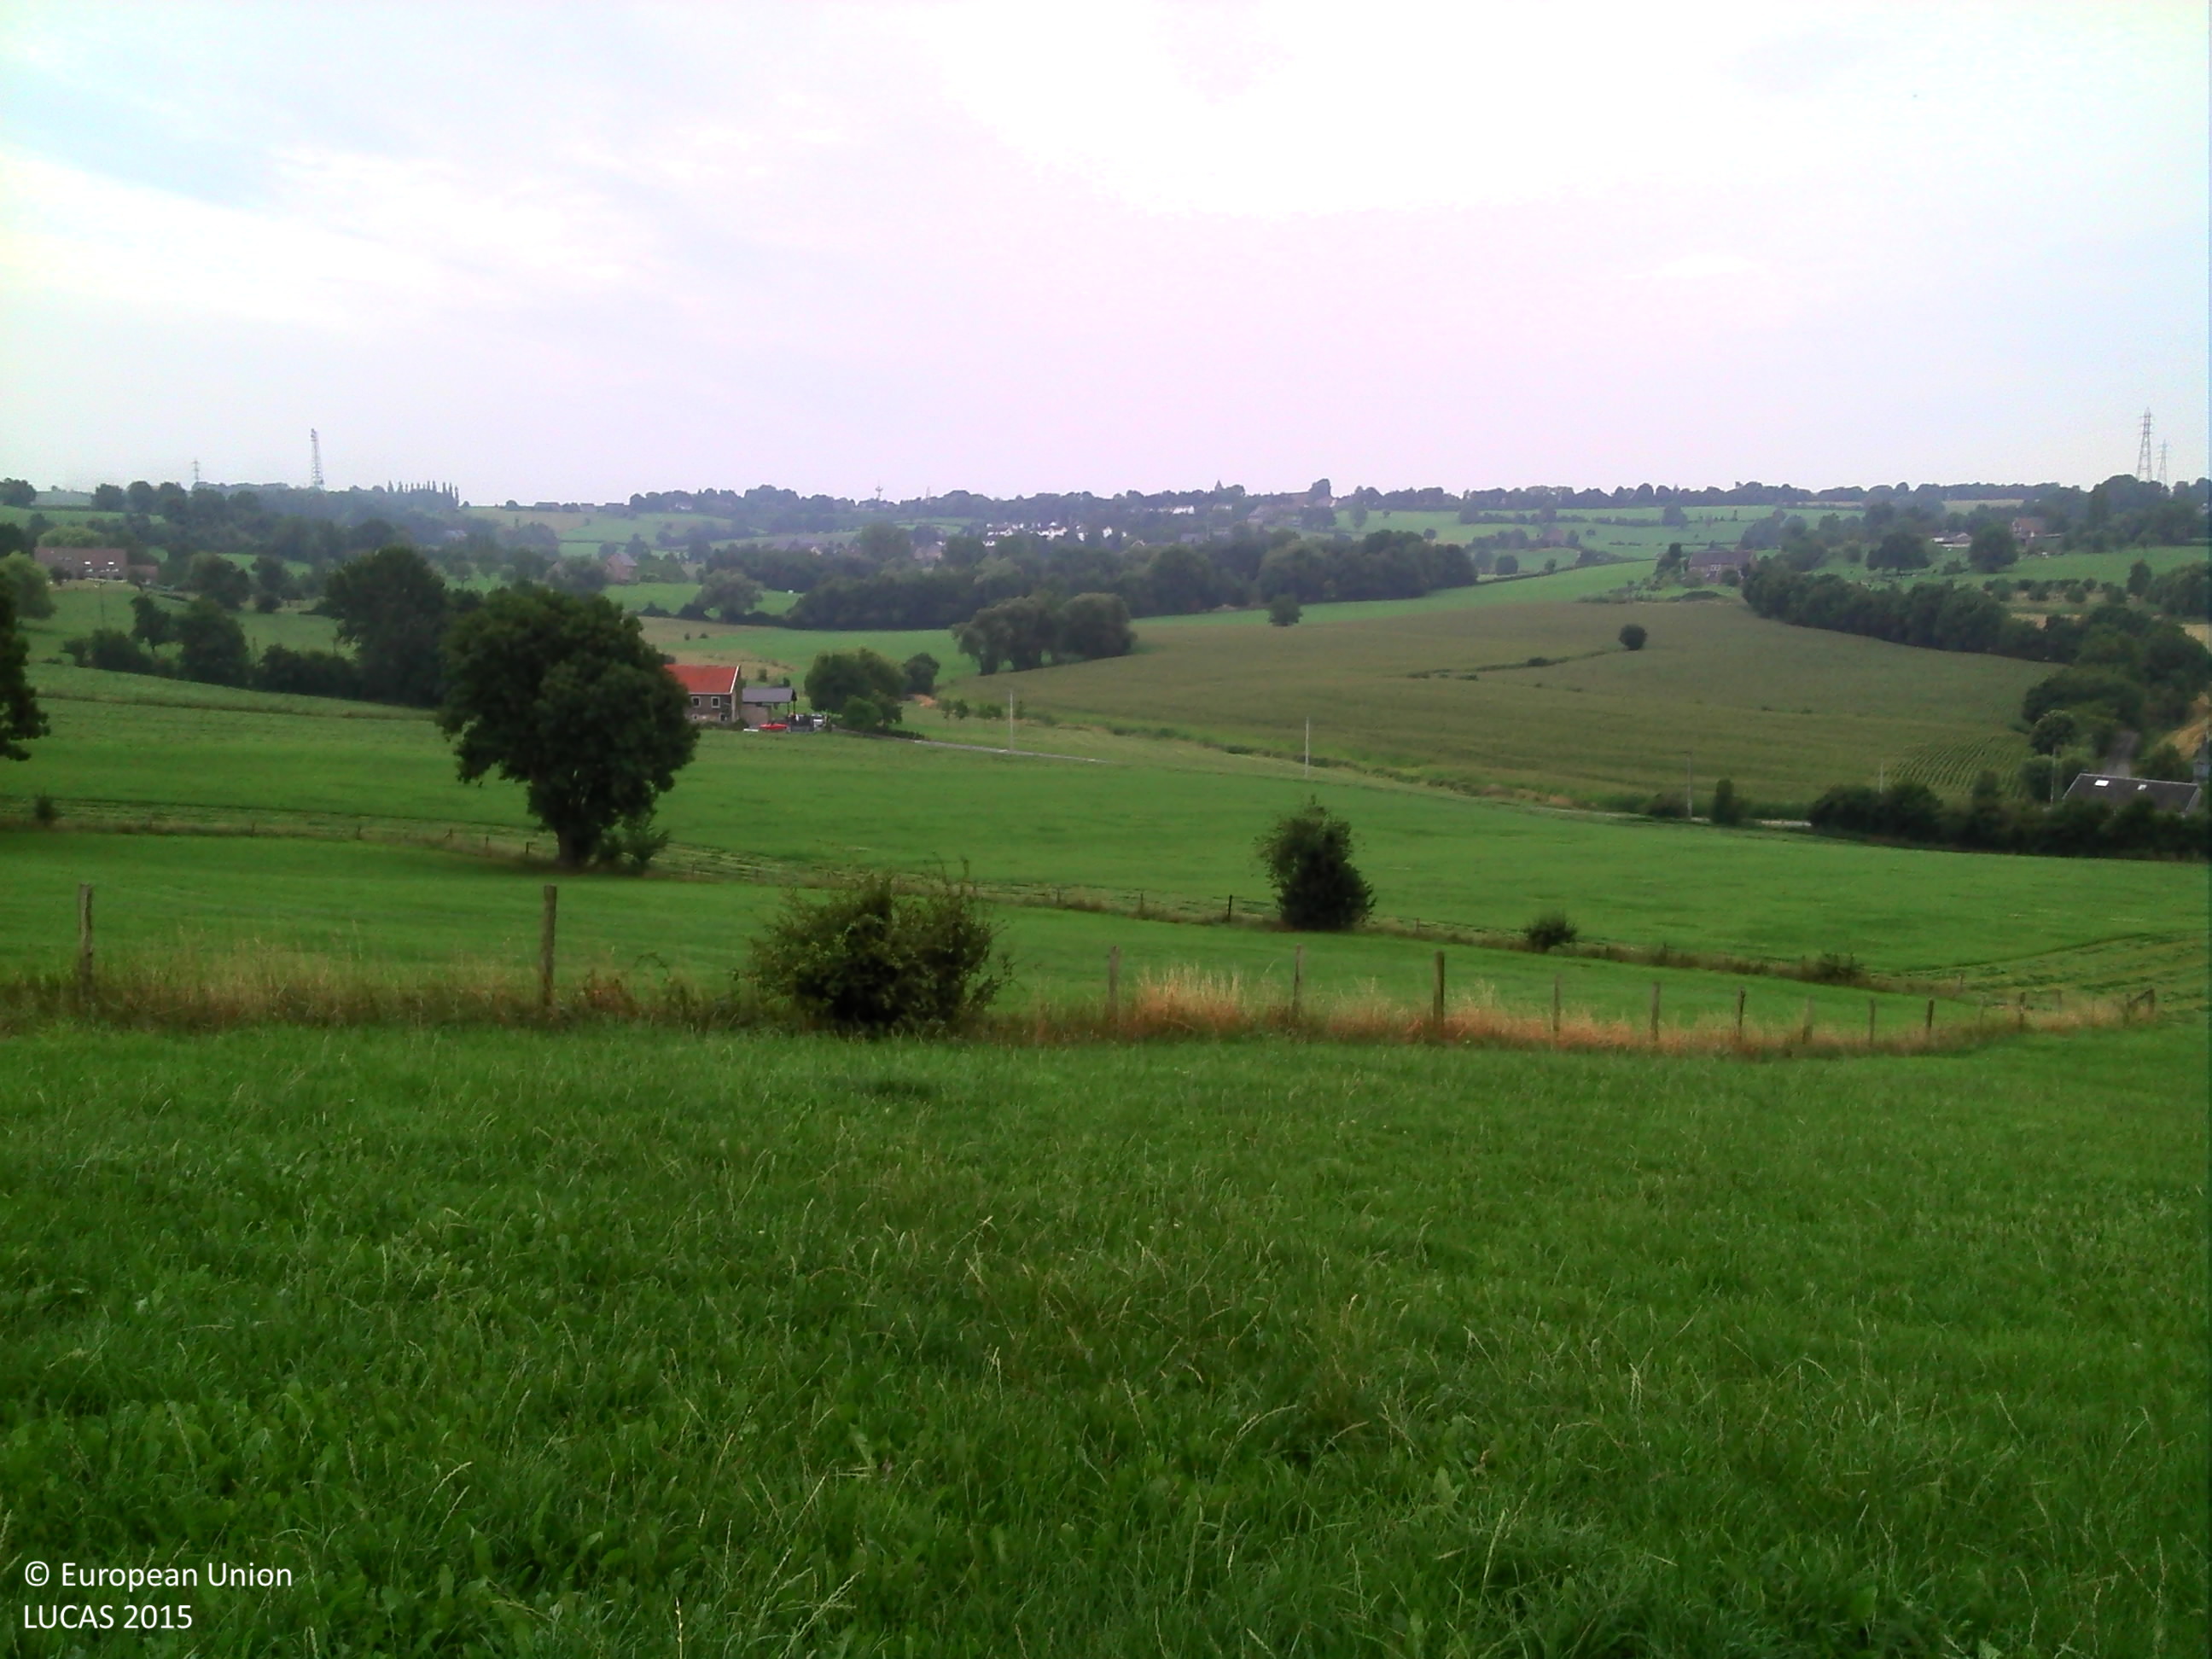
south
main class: Grassland
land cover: Grassland without tree/shrub cover
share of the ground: > 75 %
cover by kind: herbaceous plants 100 %
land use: Agriculture (excluding fallow land and kitchen gardens)
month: August
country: BE
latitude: 50.6660
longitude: 5.8250
